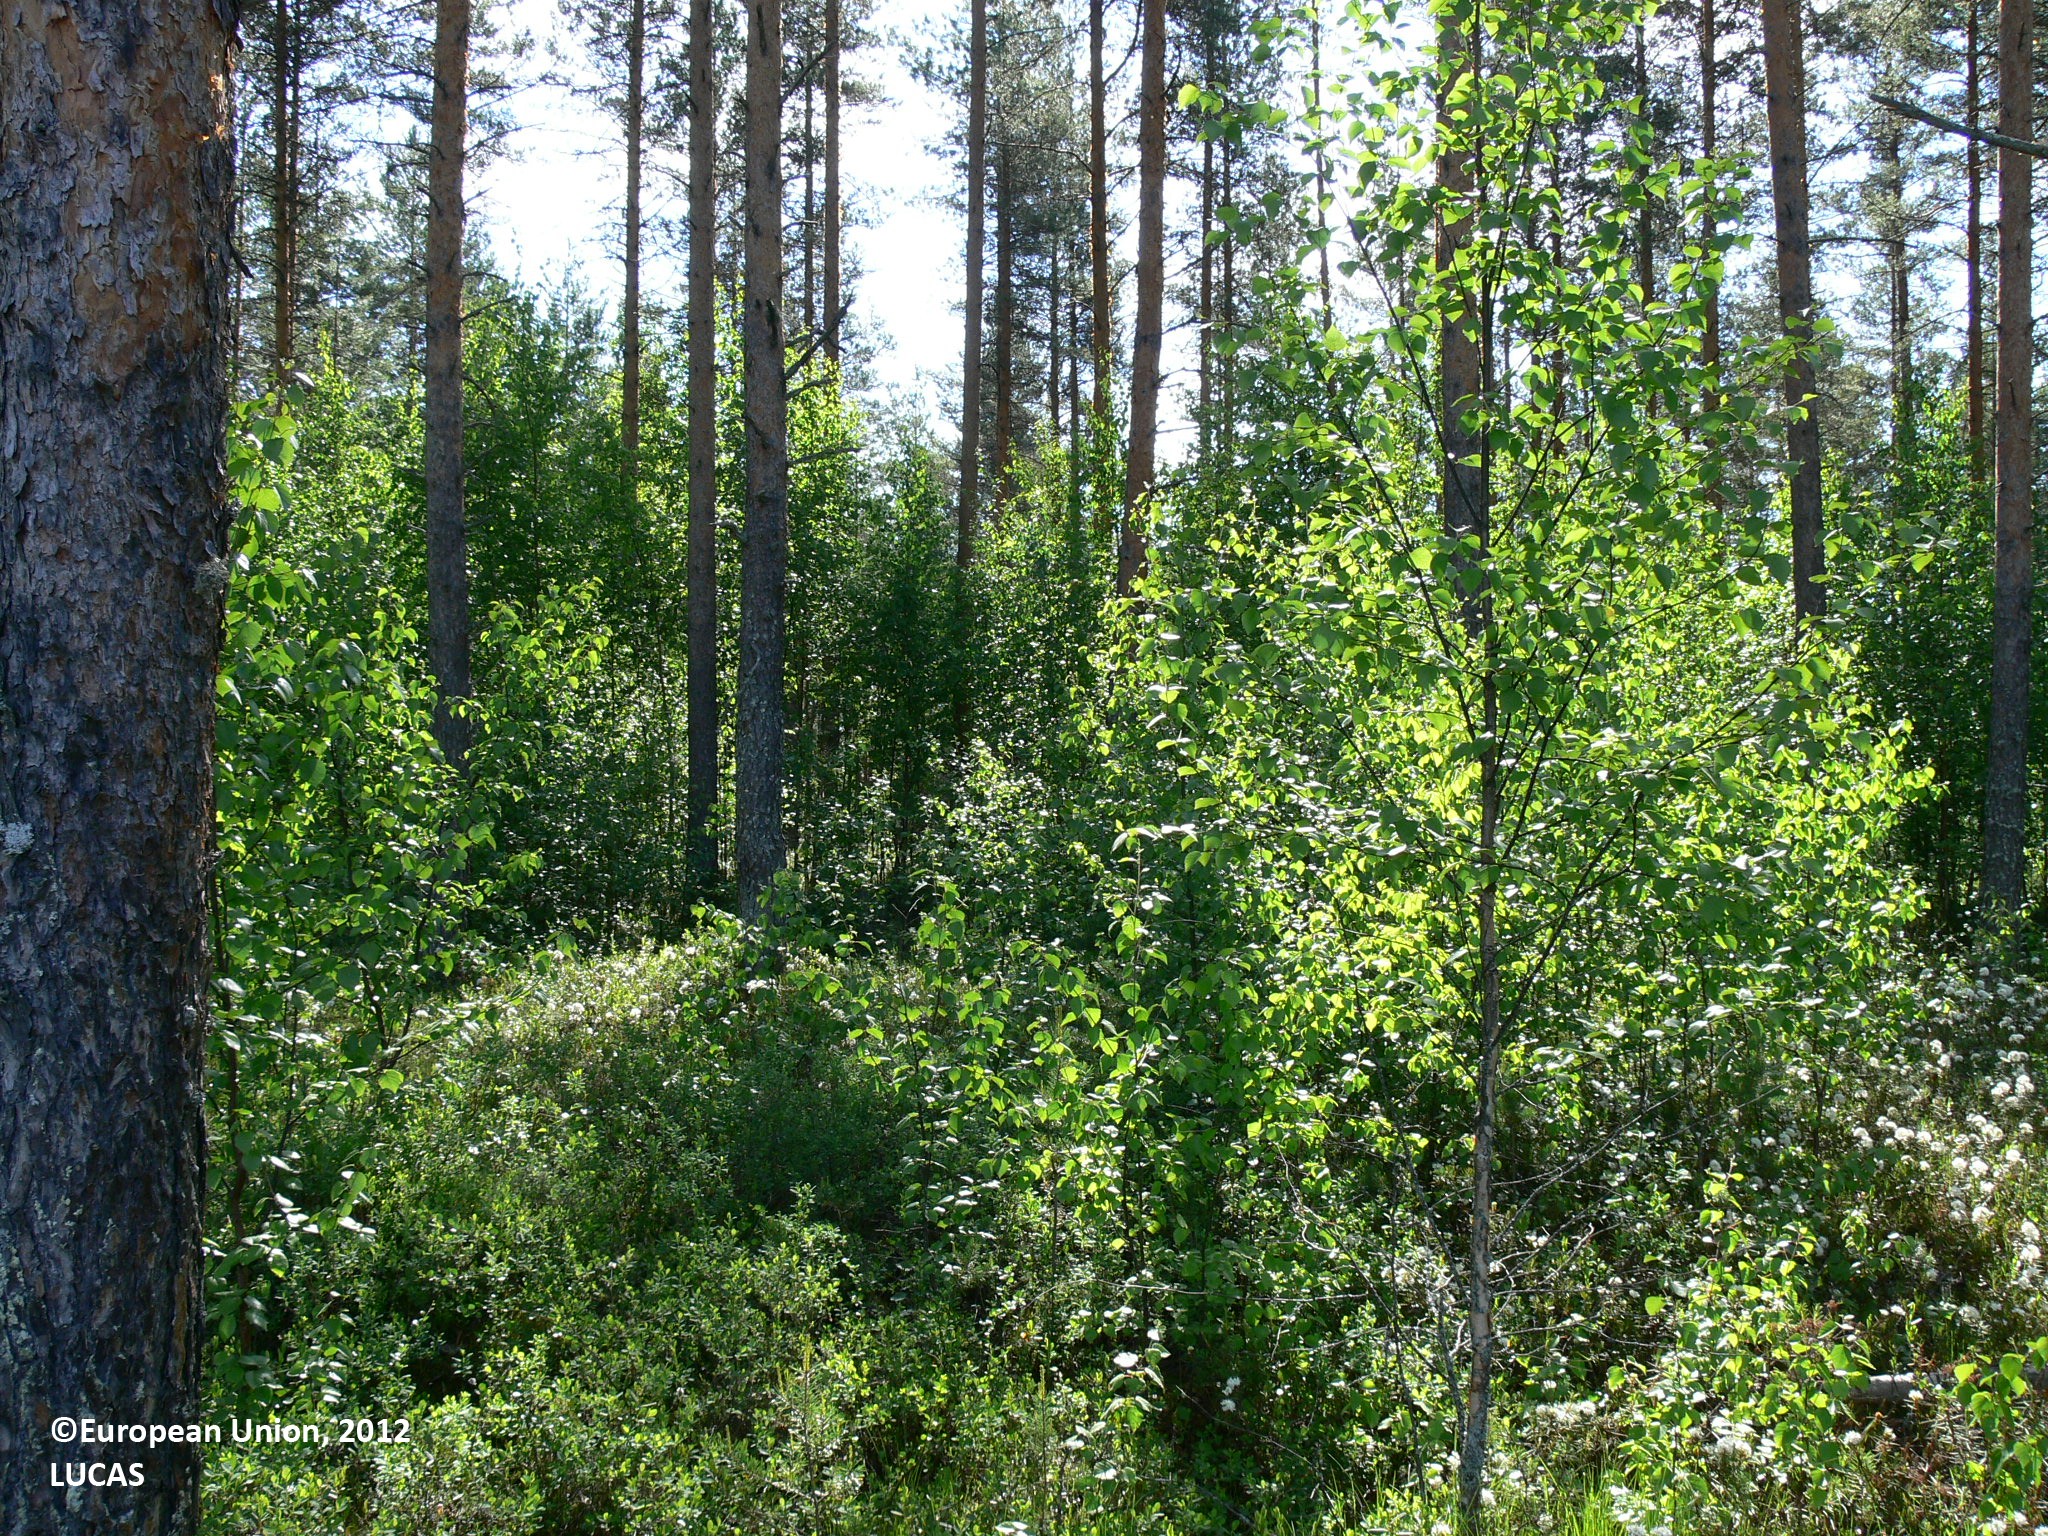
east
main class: Woodland
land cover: Pine dominated coniferous woodland
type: boreal forest
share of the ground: > 75 %
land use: Forestry
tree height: > 5 m
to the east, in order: Pine dominated coniferous woodland; Pine dominated mixed woodland; Ditches and canals; Pine dominated coniferous woodland; Ditches and canals; Pine dominated mixed woodland; Pine dominated coniferous woodland; Ditches and canals; Pine dominated coniferous woodland; Ditches and canals; Pine dominated coniferous woodland
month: June
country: FI
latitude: 62.6683
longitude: 29.8732
